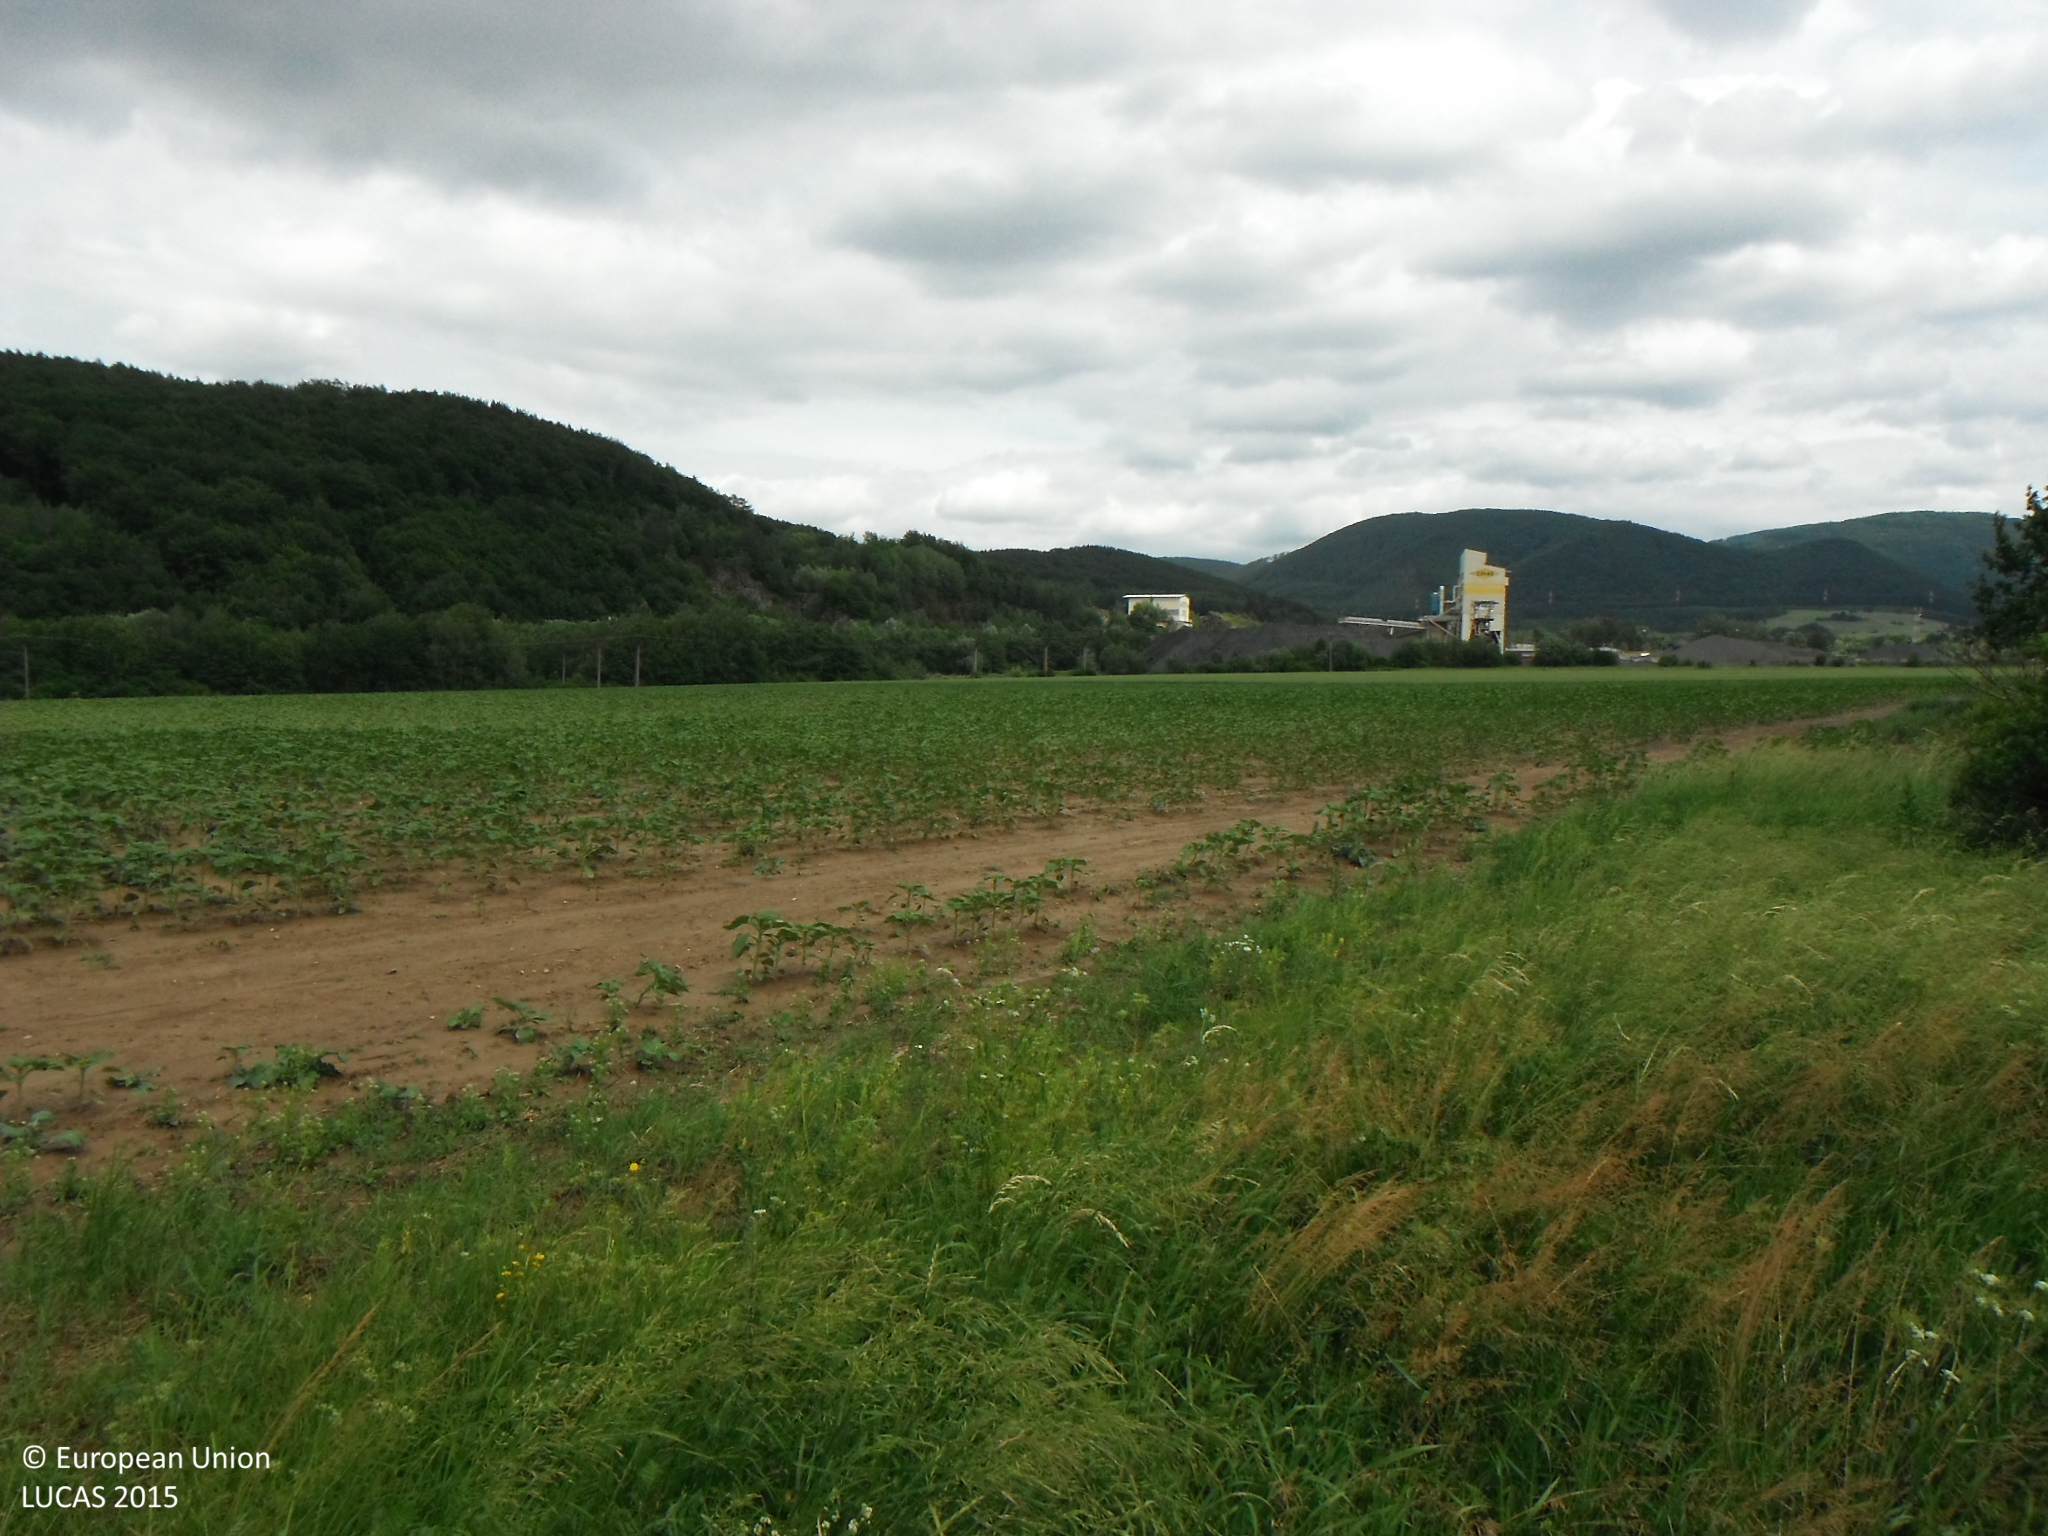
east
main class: Grassland
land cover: Spontaneously vegetated surfaces
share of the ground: > 75 %
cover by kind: herbaceous plants 100 %
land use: Abandoned areas
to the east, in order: Spontaneously vegetated surfaces; Tracks; Sunflower
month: June
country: SK
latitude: 49.0183
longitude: 21.3271
